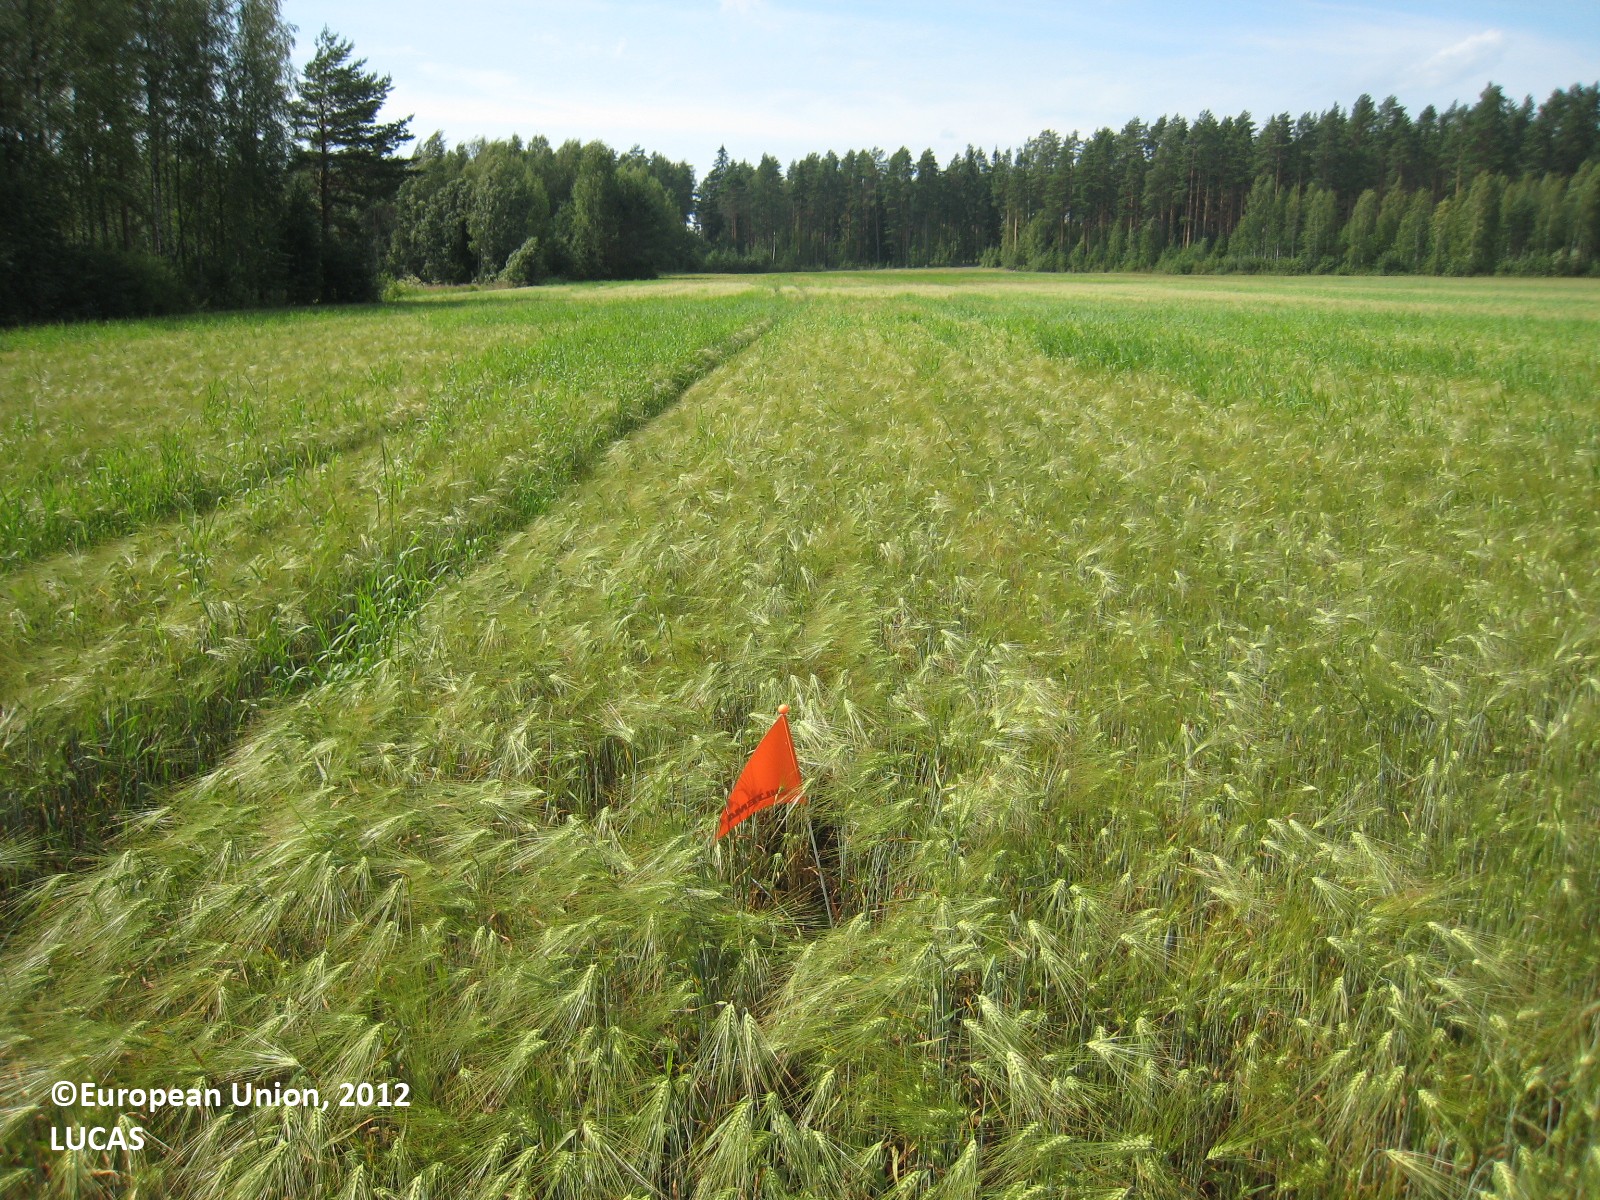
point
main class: Cropland
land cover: Barley
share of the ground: 50 - 75 %
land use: Agriculture (excluding fallow land and kitchen gardens)
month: July
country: FI
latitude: 61.7808
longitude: 26.0378
